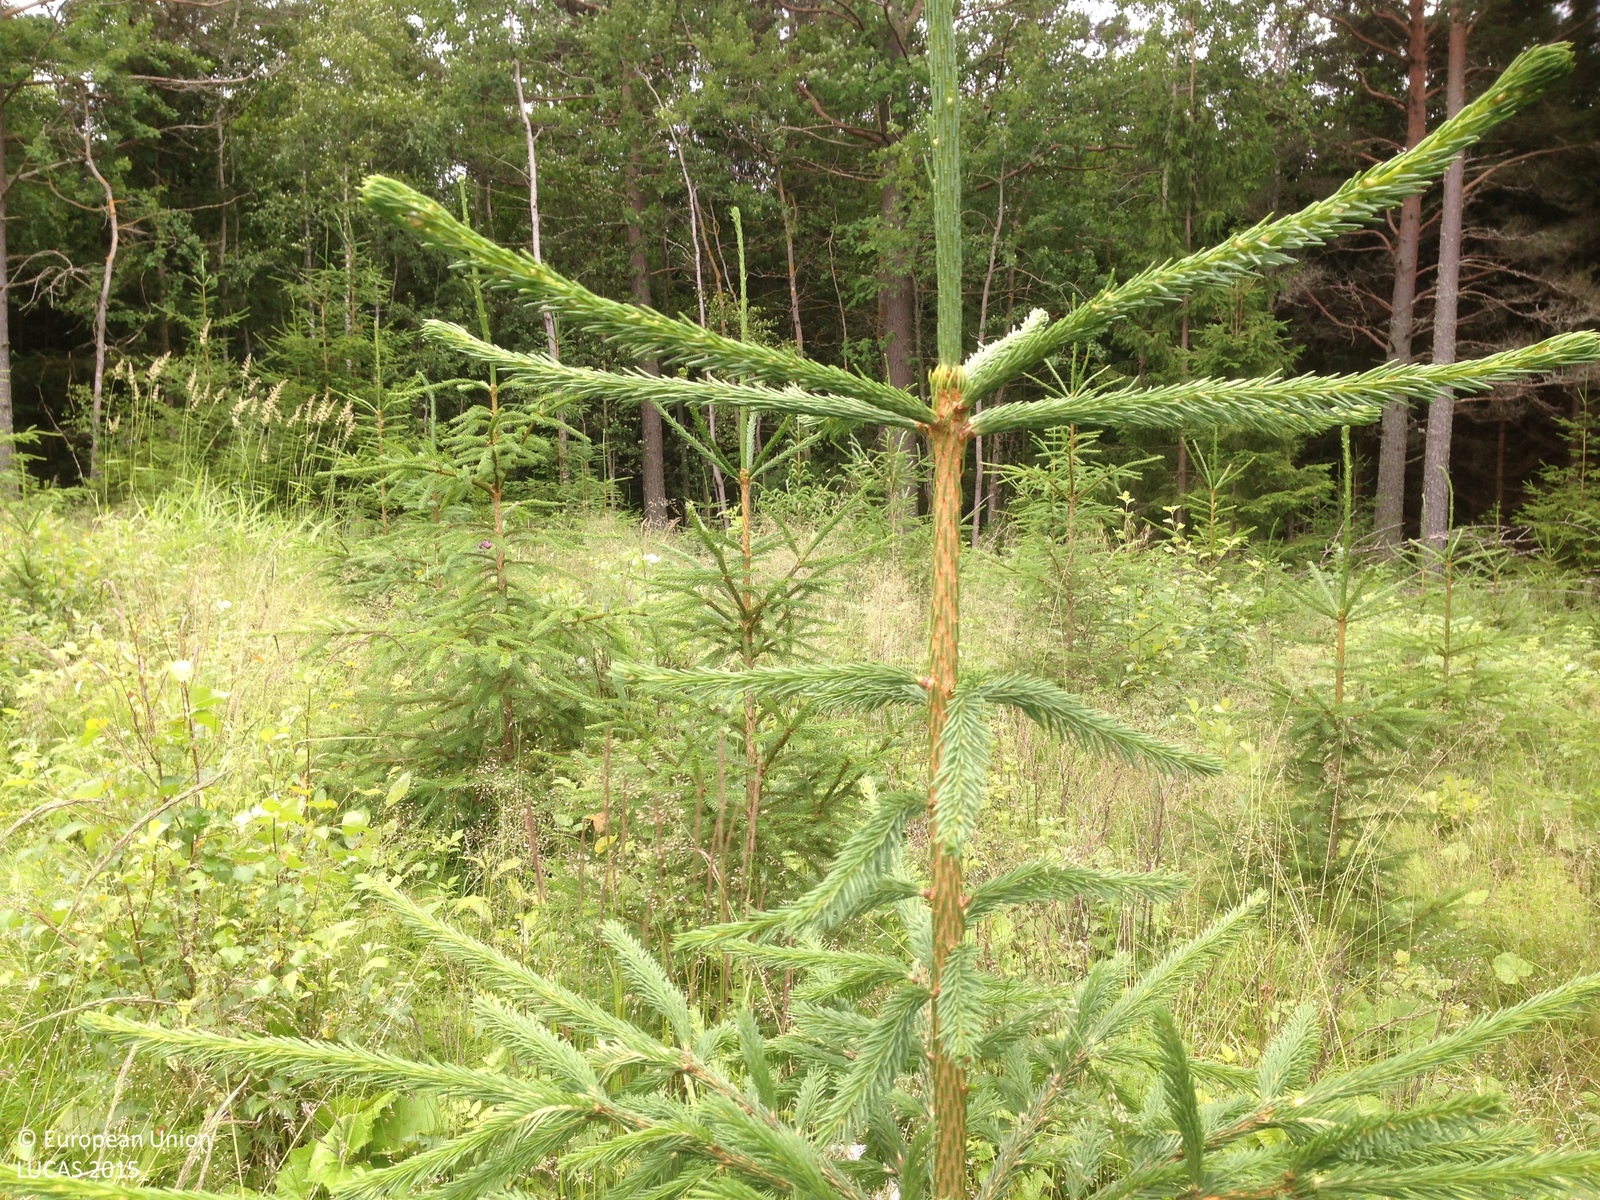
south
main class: Woodland
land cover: Spruce dominated coniferous woodland
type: boreal forest
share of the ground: 25 - 50 %
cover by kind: coniferous forest trees 40 %, herbaceous plants 25 %, lichens and mosses 25 %, broadleaved forest trees 10 %
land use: Forestry
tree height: < 5 m
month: July
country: SE
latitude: 59.8814
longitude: 16.9778
